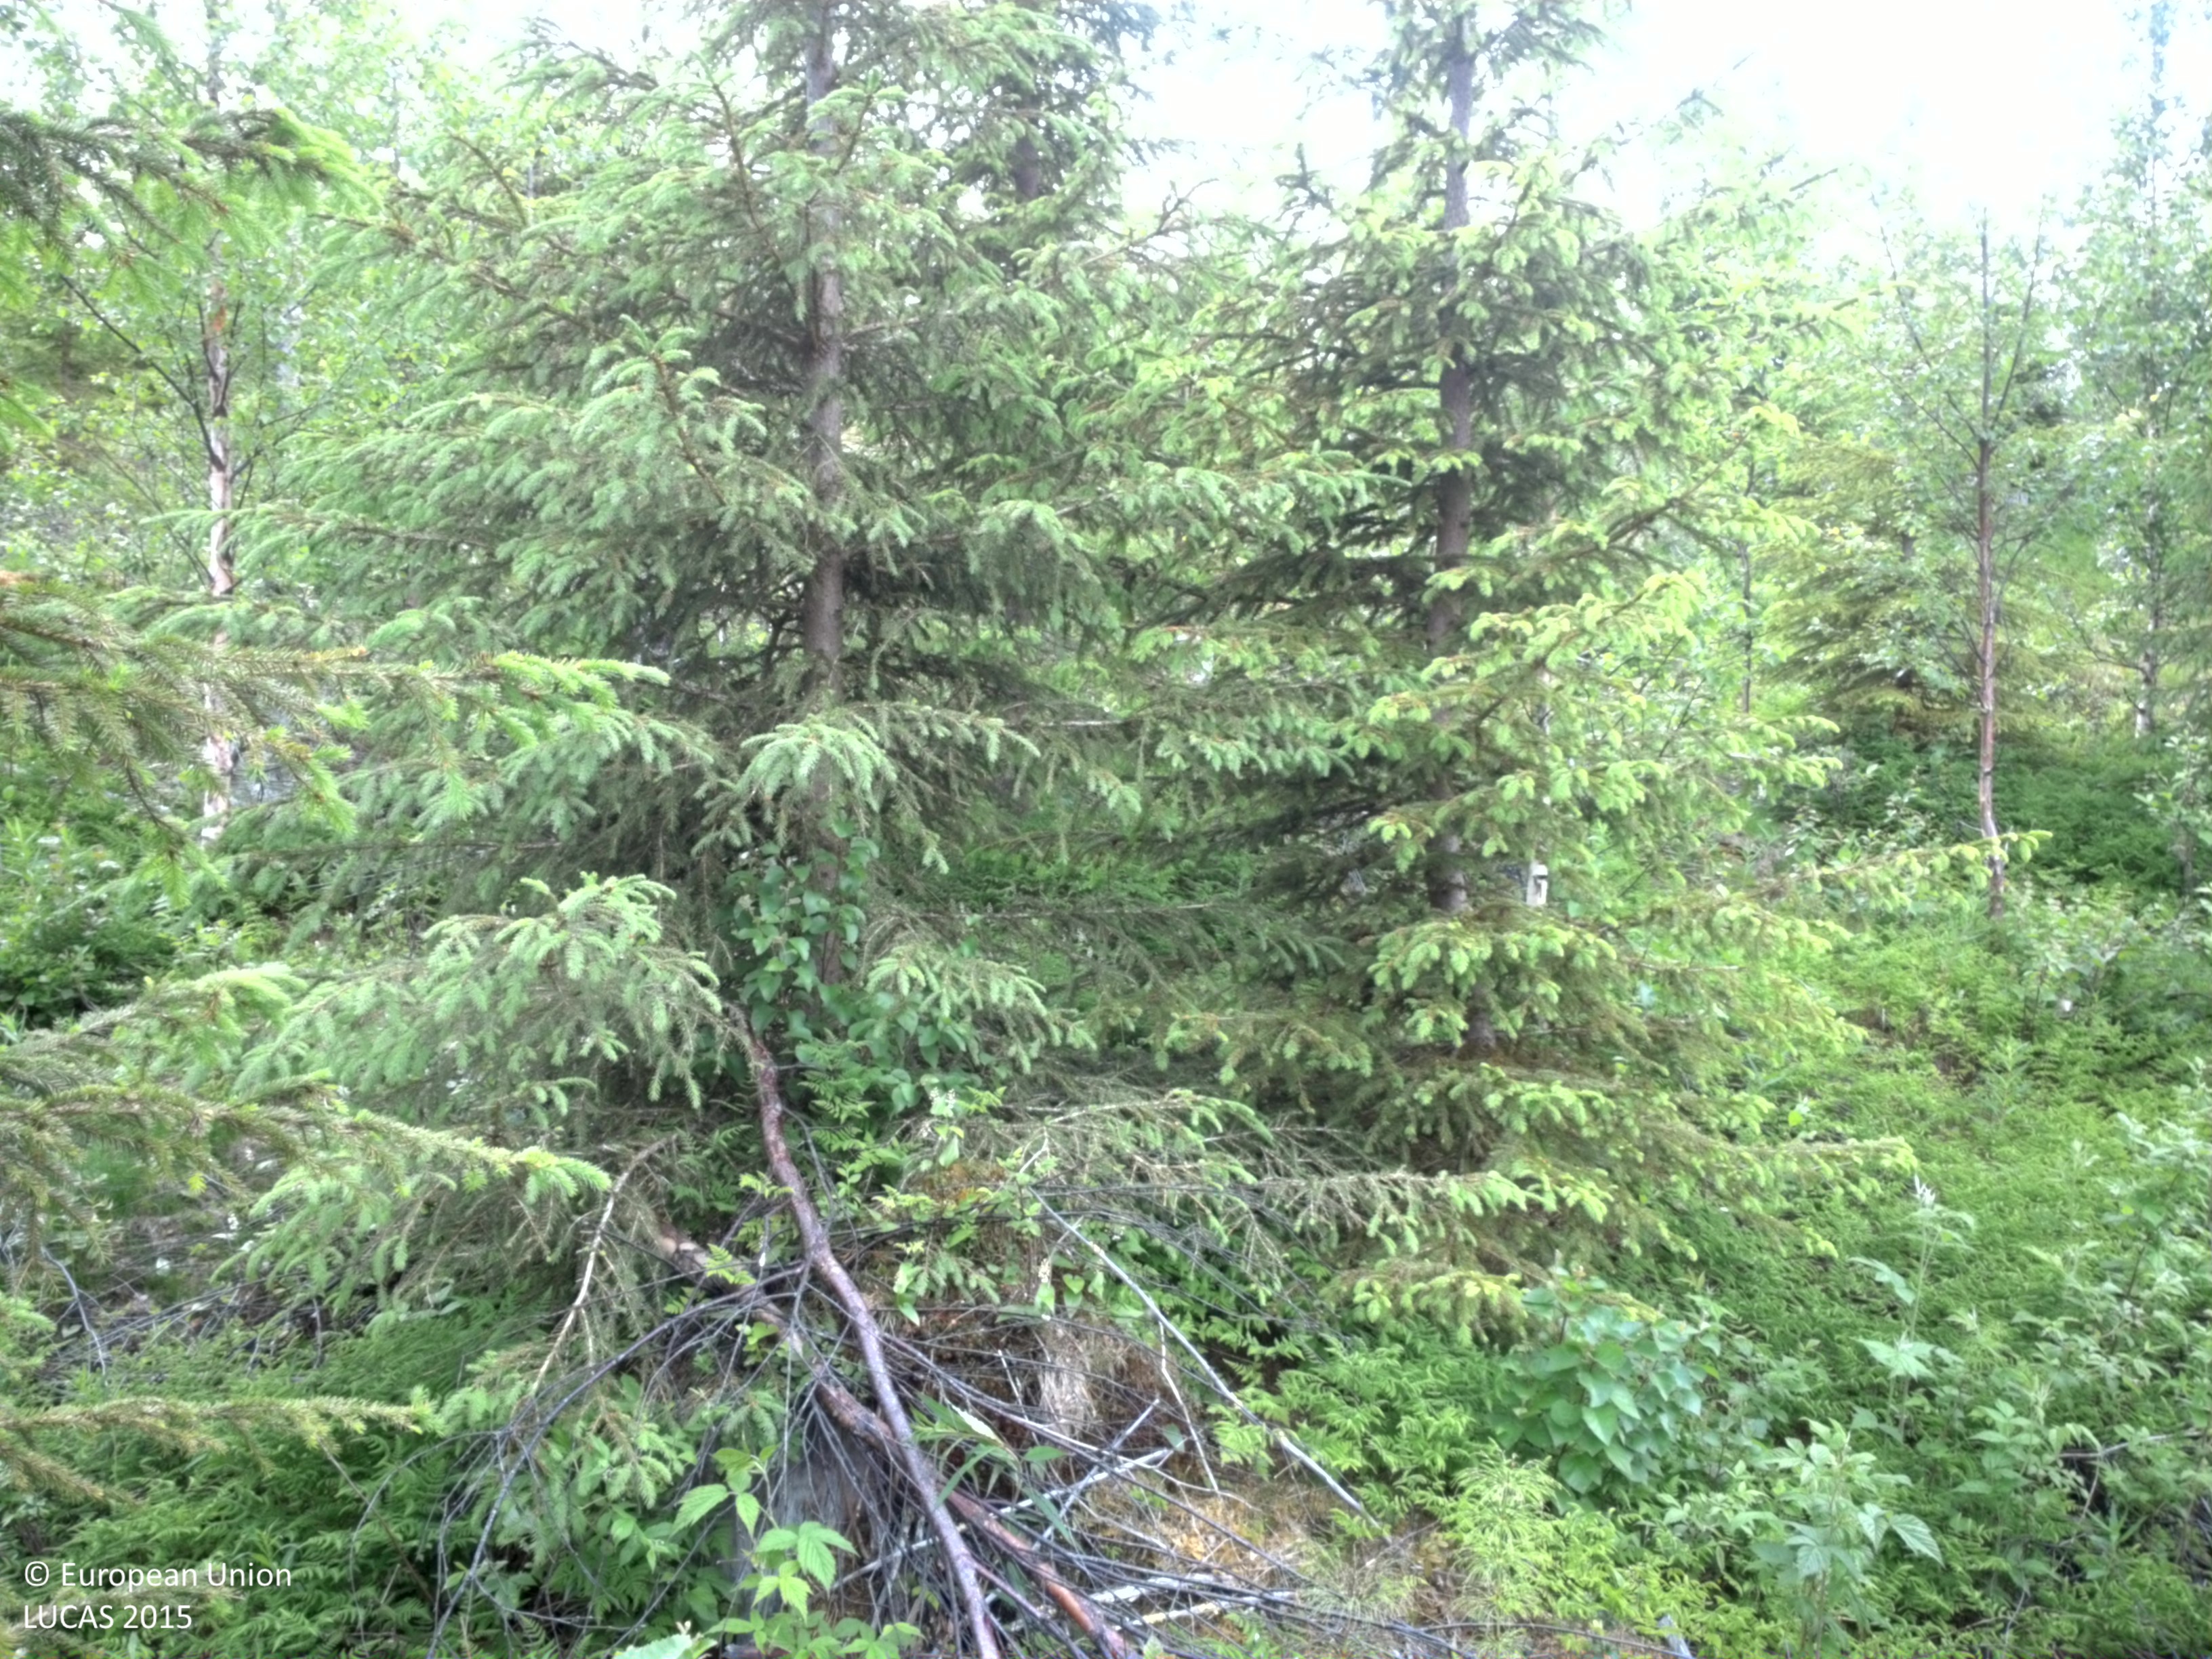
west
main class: Woodland
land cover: Spruce dominated mixed woodland
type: boreal forest
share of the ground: 50 - 75 %
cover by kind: coniferous forest trees 45 %, herbaceous plants 20 %, broadleaved forest trees 15 %, shrubs 15 %, lichens and mosses 5 %
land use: Forestry
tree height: > 5 m
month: July
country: SE
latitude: 64.5375
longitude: 18.0768
